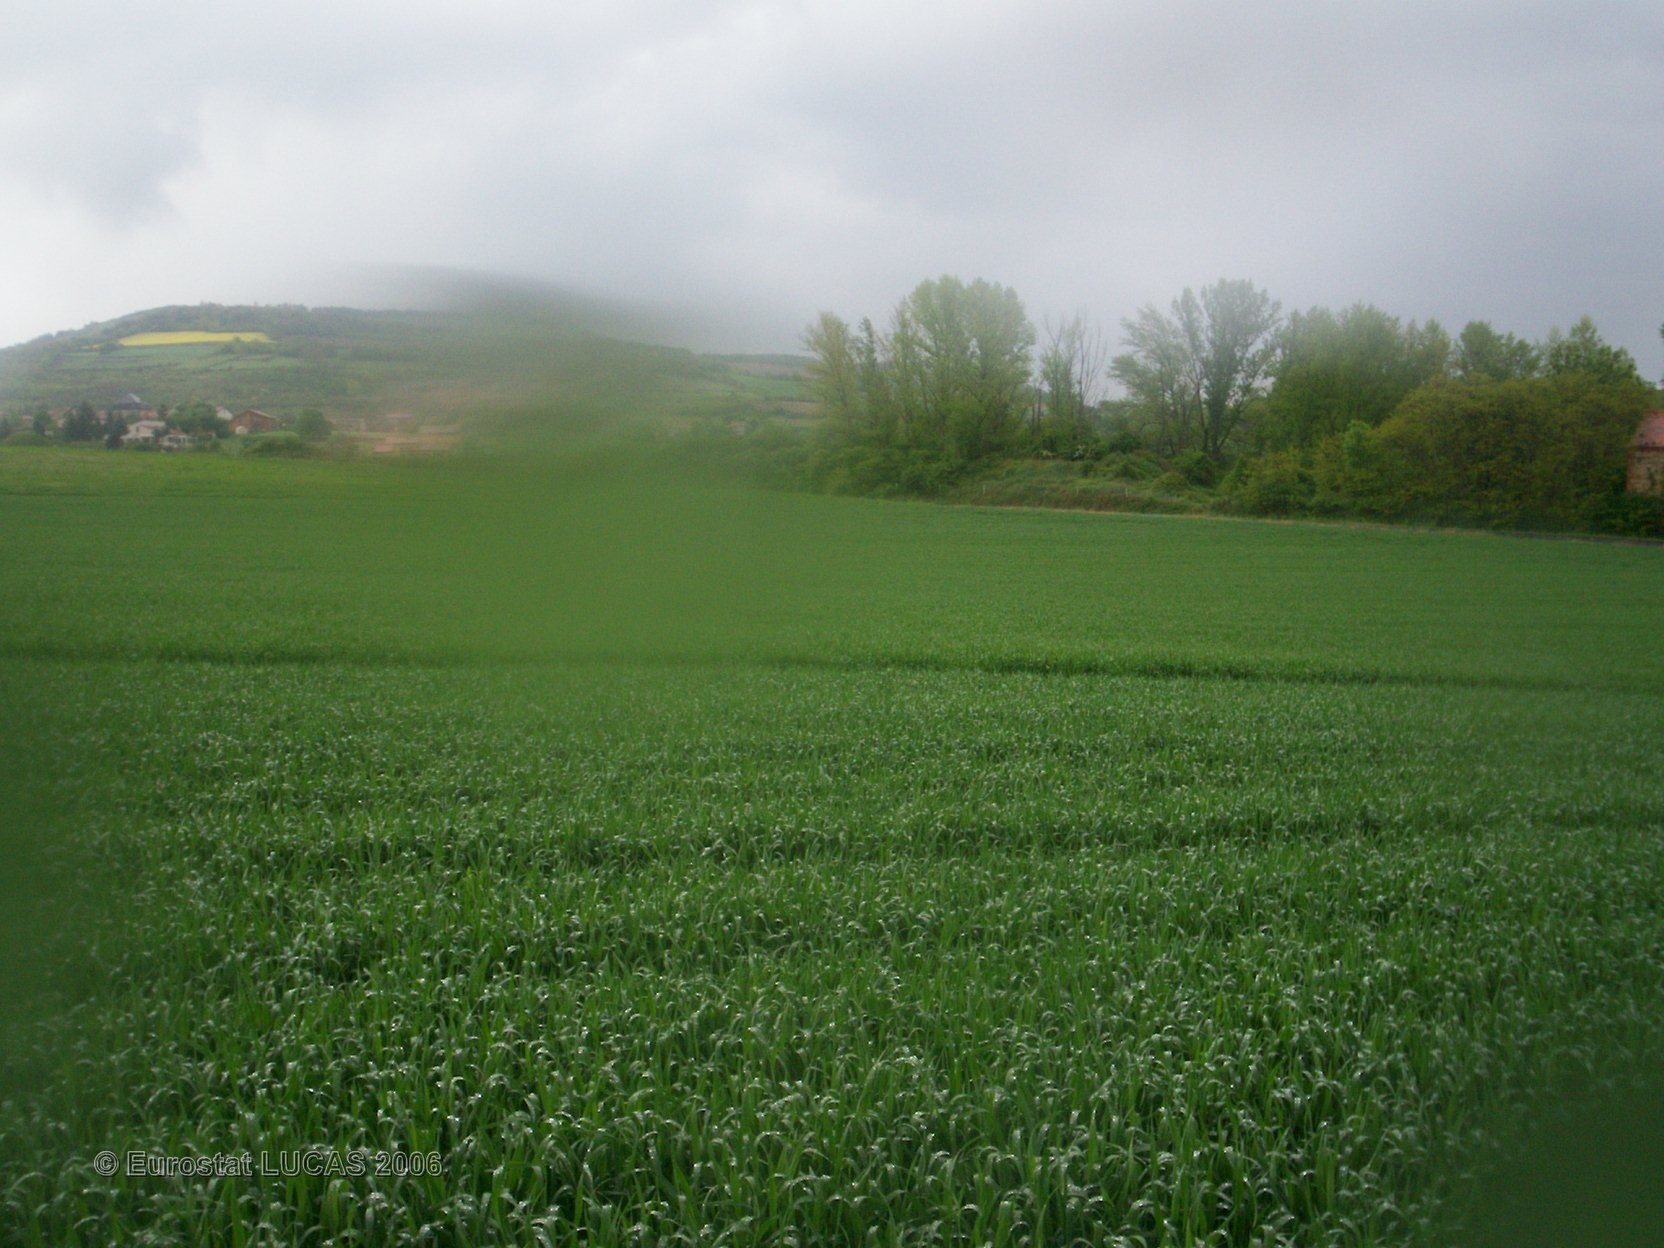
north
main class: Cropland
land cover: Common wheat
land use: Agriculture (excluding fallow land and kitchen gardens)
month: May
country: FR
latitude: 45.6050
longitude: 3.1152
